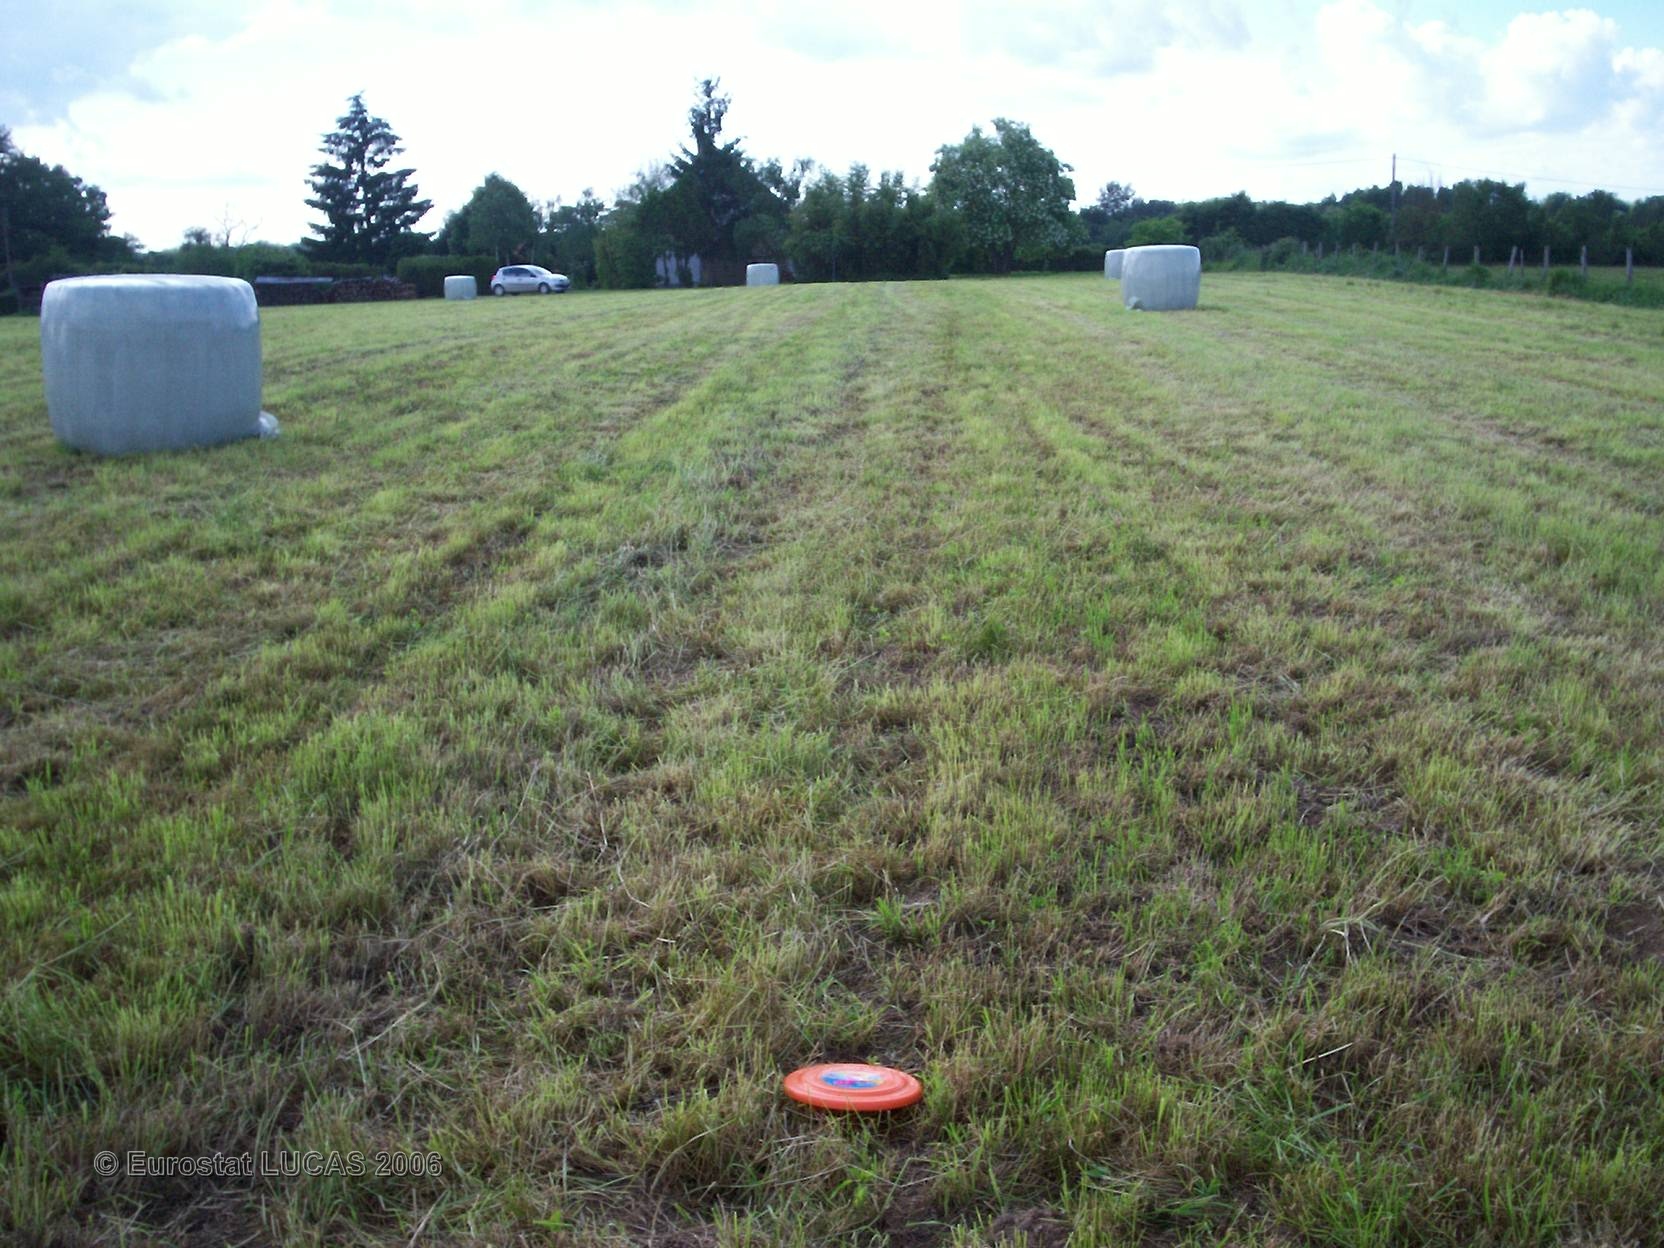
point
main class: Grassland
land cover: Grassland without tree/shrub cover
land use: Agriculture (excluding fallow land and kitchen gardens)
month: May
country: FR
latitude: 46.8289
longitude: 3.0352
